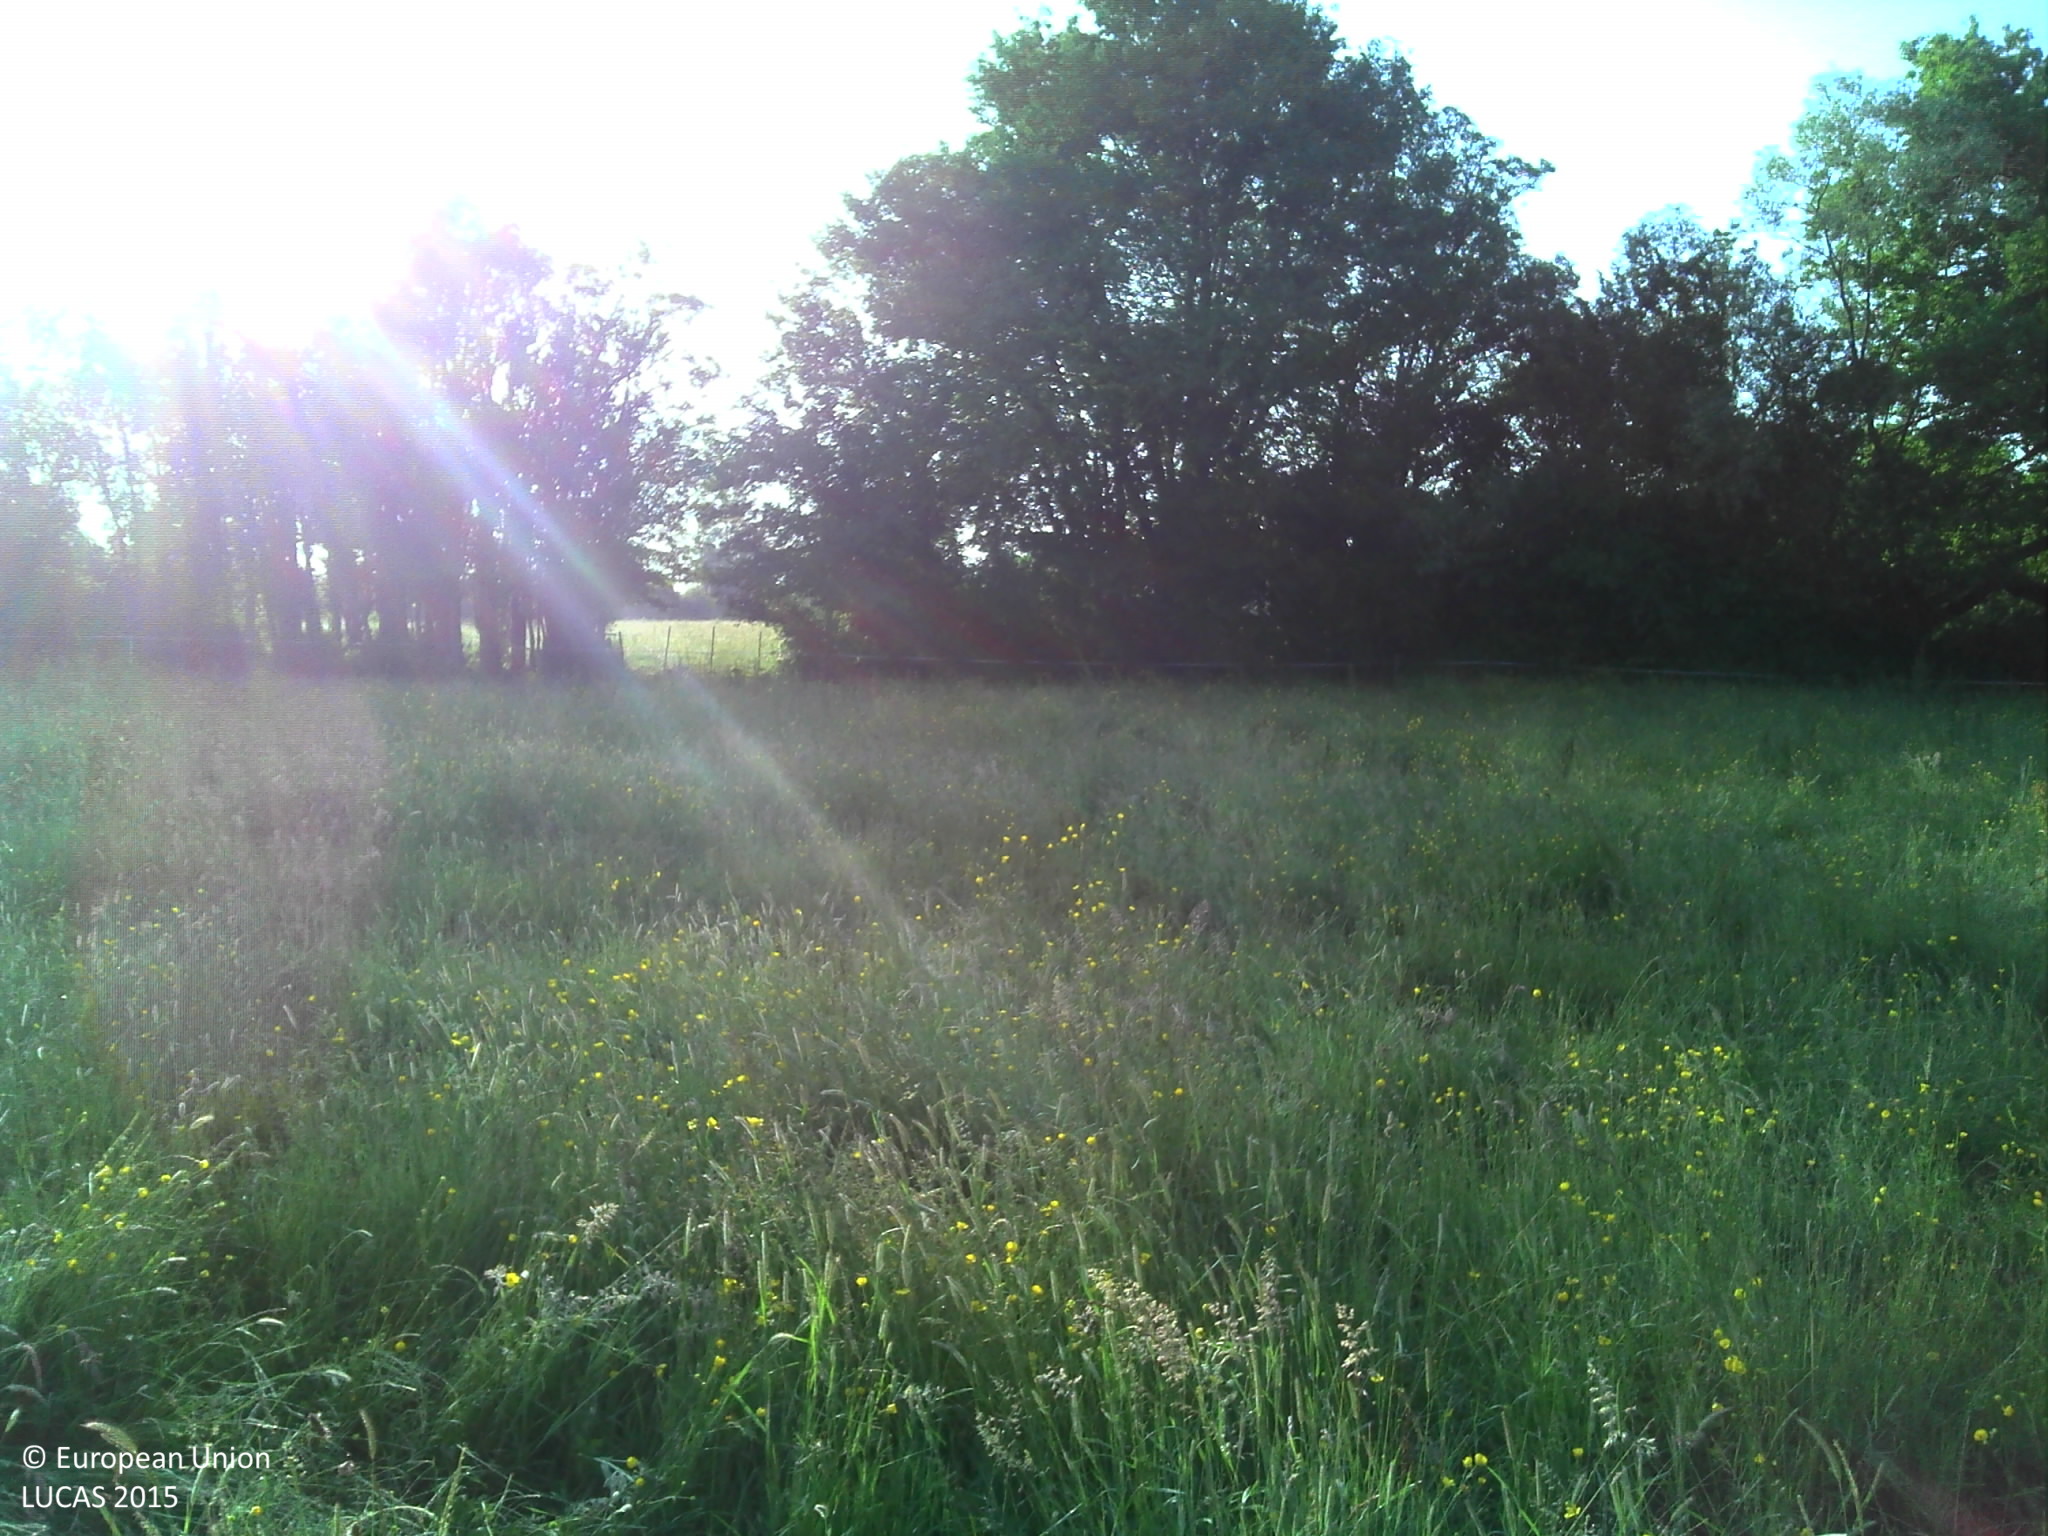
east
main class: Grassland
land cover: Grassland without tree/shrub cover
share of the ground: > 75 %
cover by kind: herbaceous plants 100 %
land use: Agriculture (excluding fallow land and kitchen gardens)
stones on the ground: < 10 %
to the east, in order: Grassland without tree/shrub cover; Fences; Broadleaved woodland; Fences; Grassland without tree/shrub cover; Broadleaved woodland
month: June
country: FR
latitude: 46.9747
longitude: 2.7782
